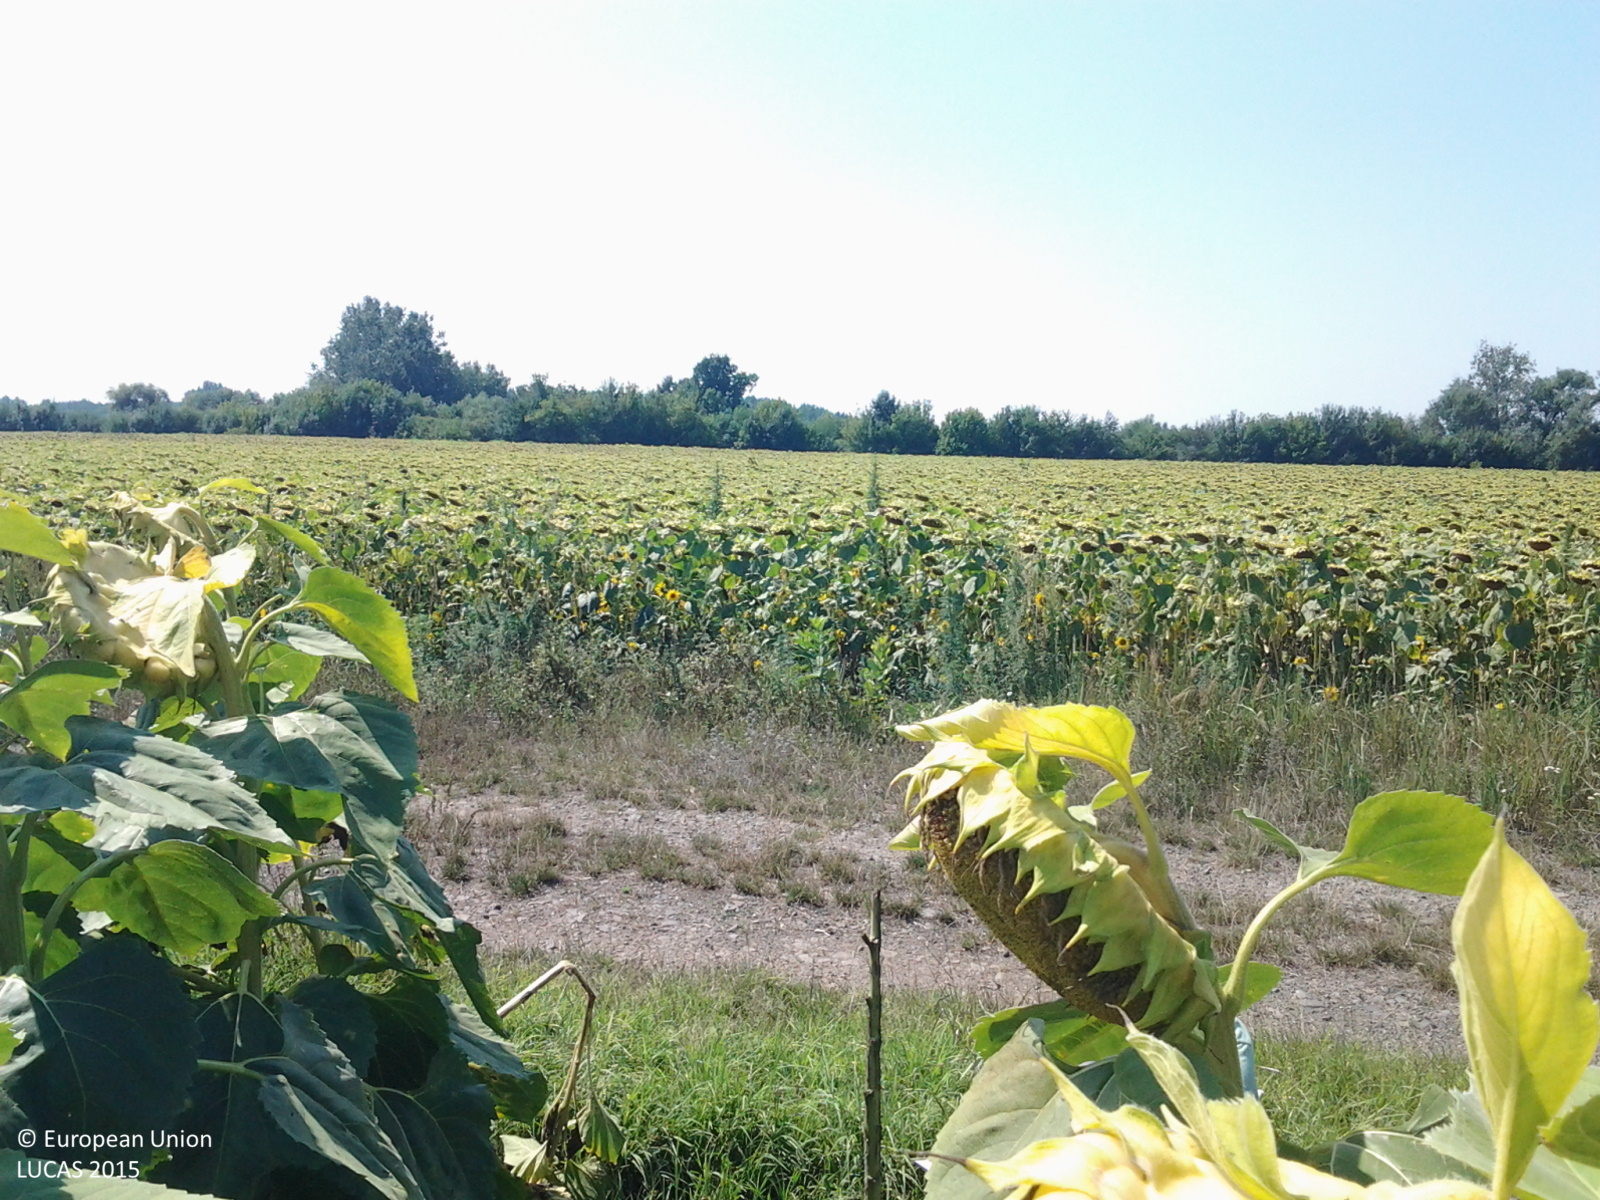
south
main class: Cropland
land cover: Sunflower
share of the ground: > 75 %
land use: Agriculture (excluding fallow land and kitchen gardens)
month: August
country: HU
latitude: 47.3051
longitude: 19.9045
